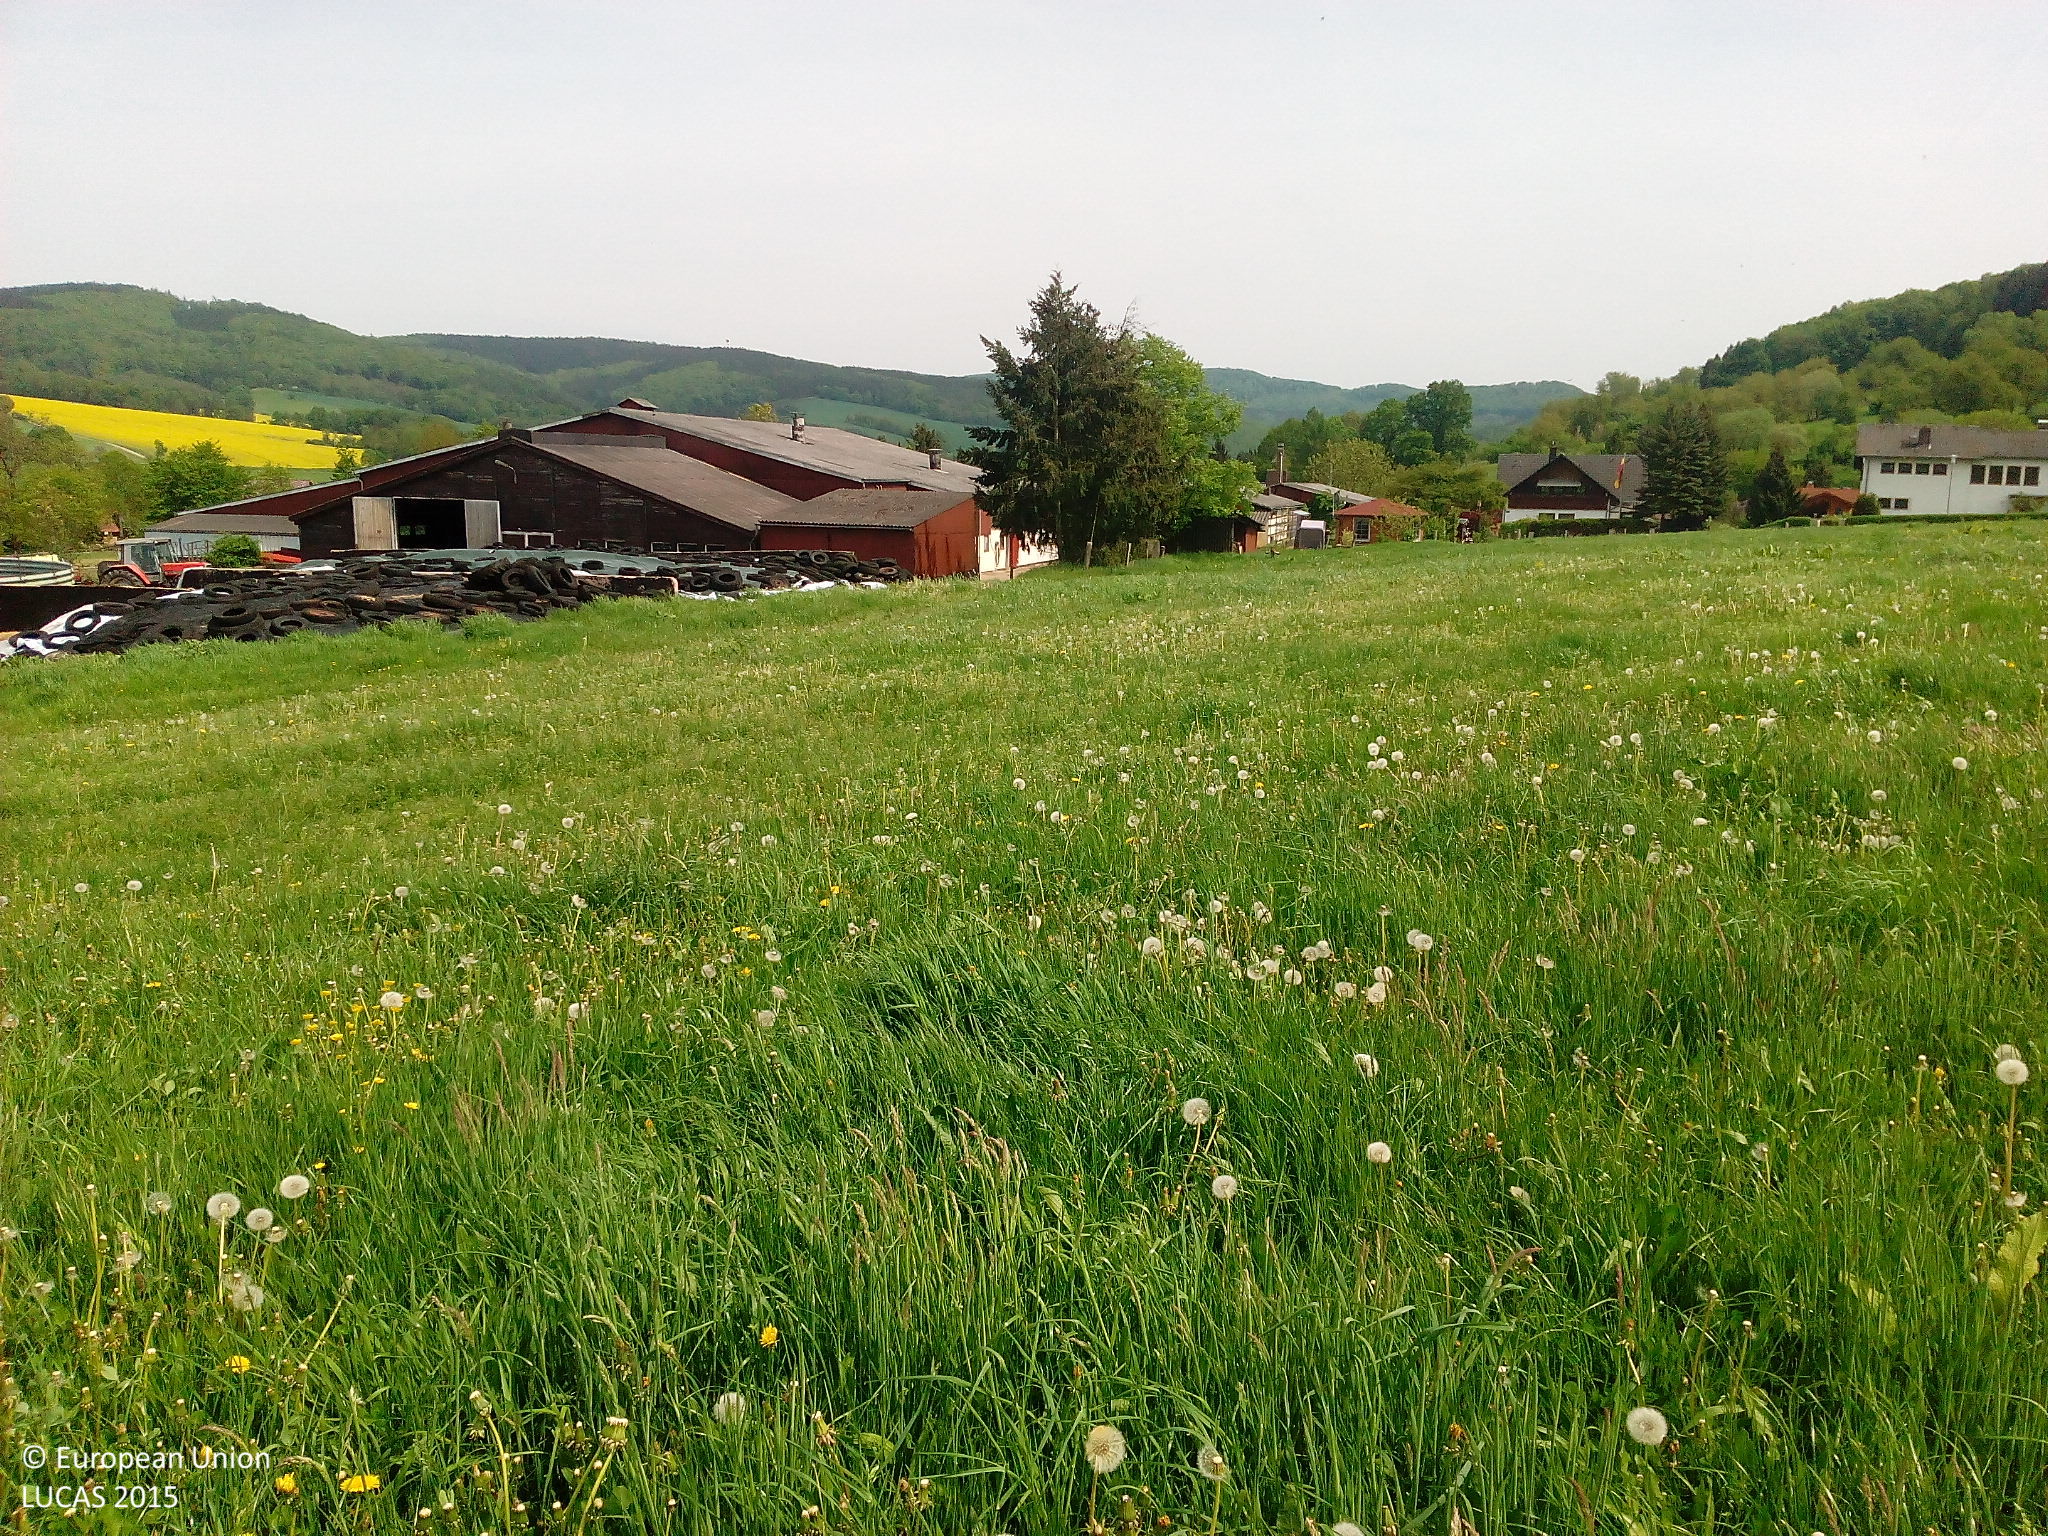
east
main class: Grassland
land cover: Grassland without tree/shrub cover
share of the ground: > 75 %
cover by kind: herbaceous plants 100 %
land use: Agriculture (excluding fallow land and kitchen gardens)
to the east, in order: Grassland without tree/shrub cover; Artificial constructions in urban areas
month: May
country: DE
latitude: 51.2989
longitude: 9.9570
